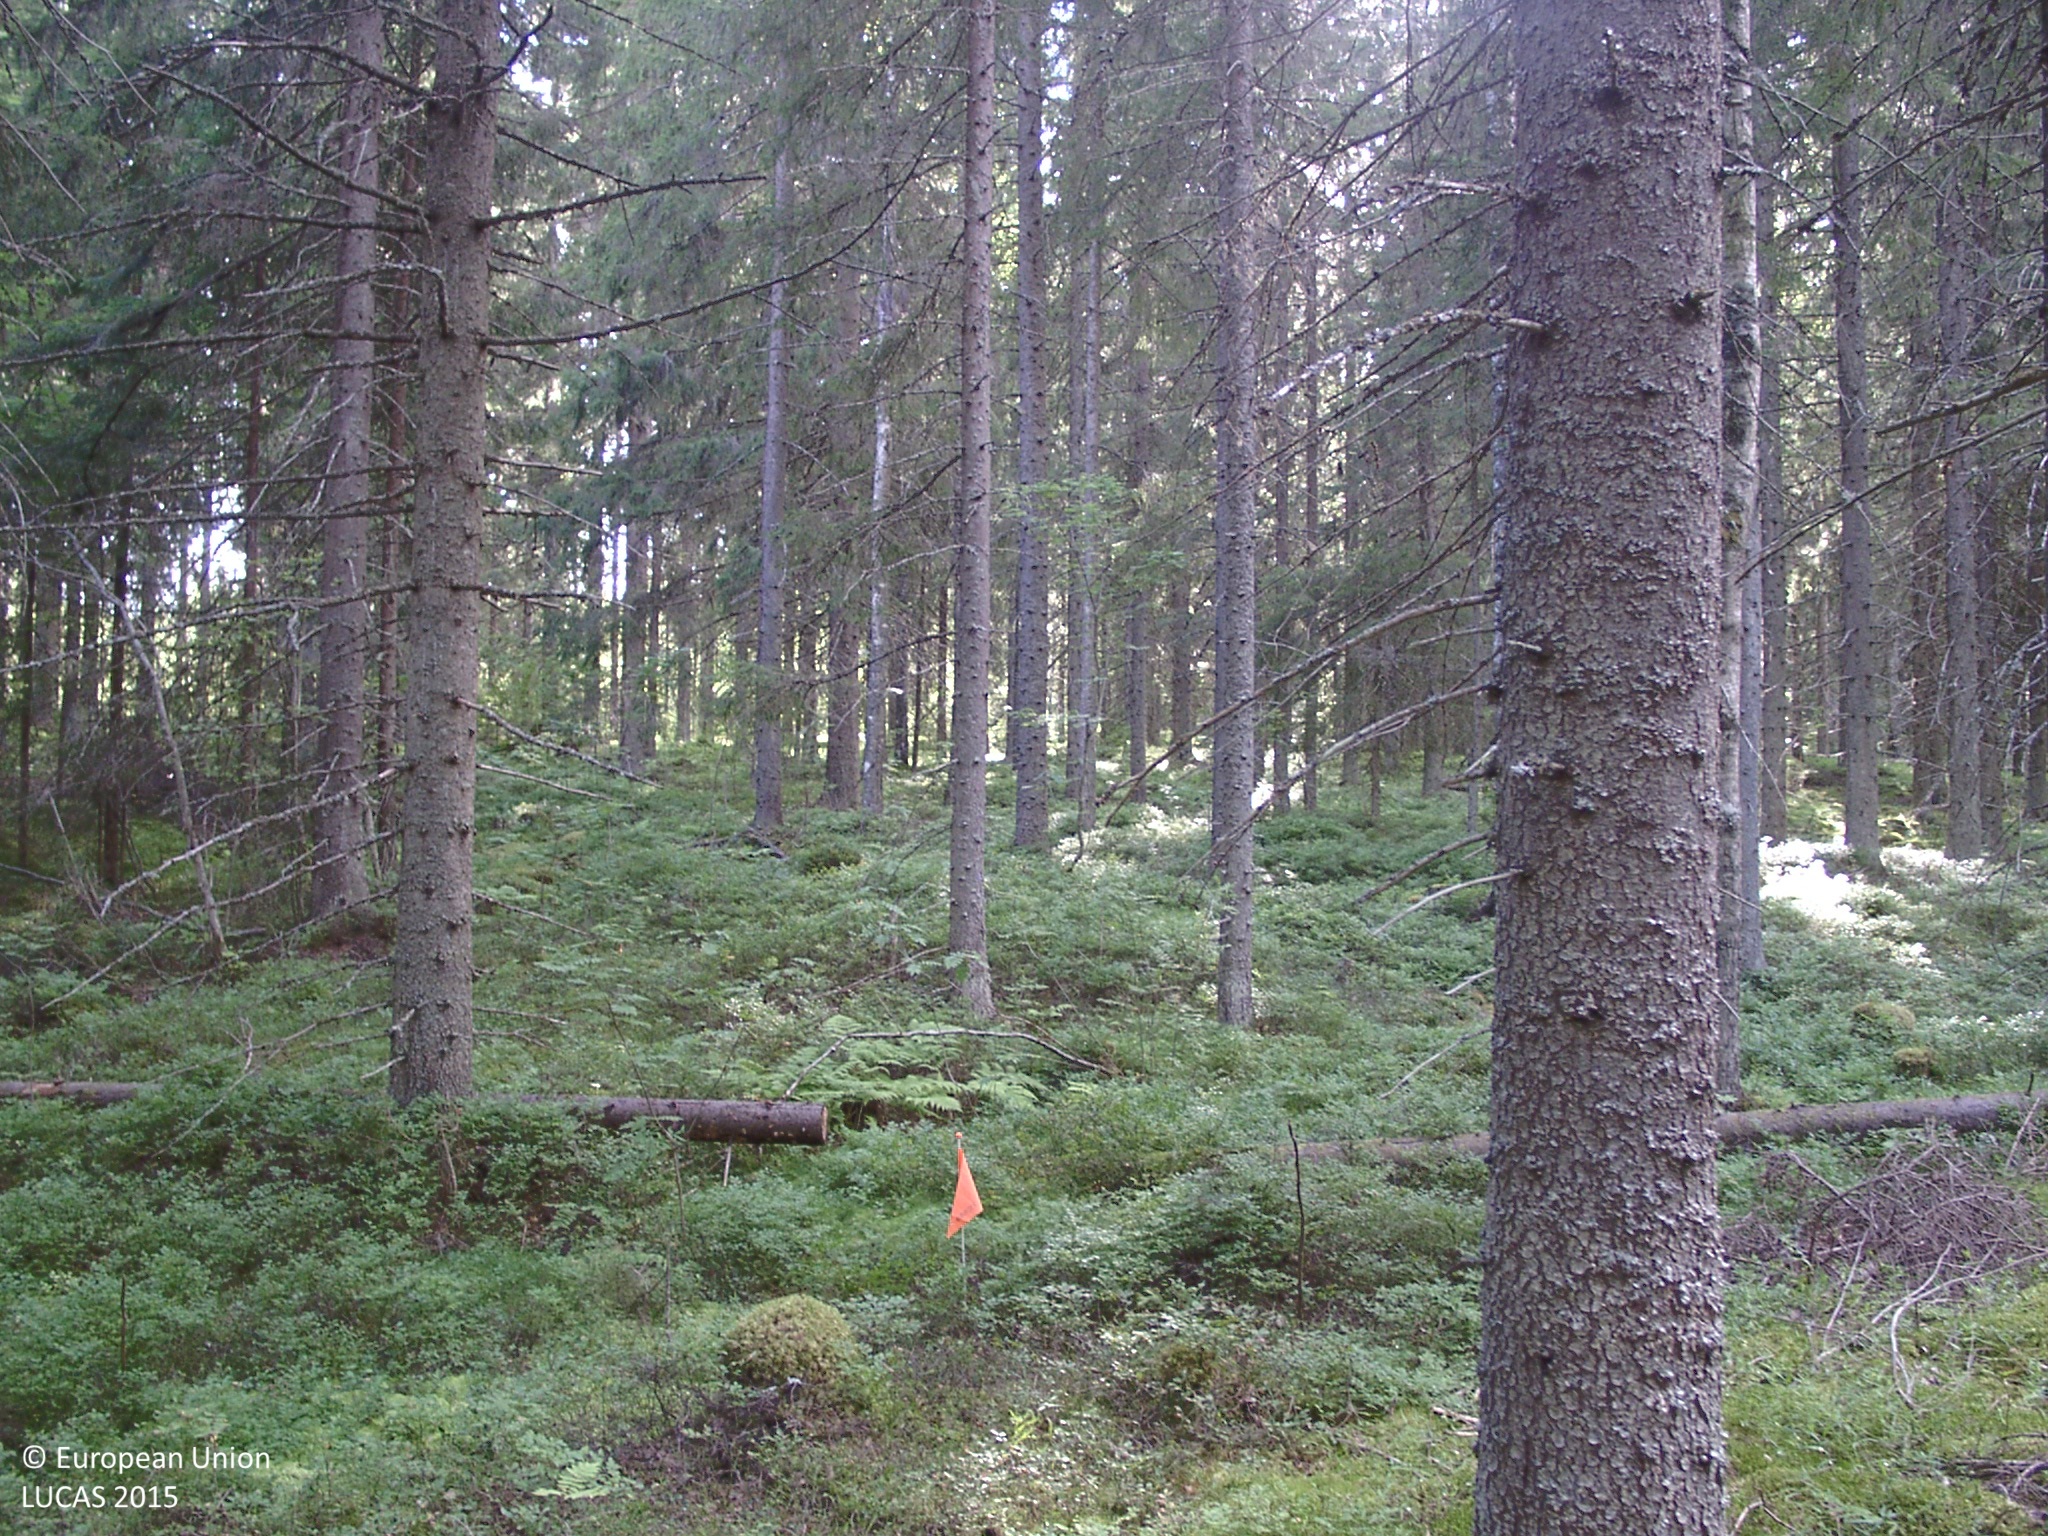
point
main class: Woodland
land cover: Spruce dominated coniferous woodland
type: boreal forest
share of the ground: > 75 %
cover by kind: coniferous forest trees 75 %, shrubs 10 %, broadleaved forest trees 5 %, herbaceous plants 5 %, lichens and mosses 5 %
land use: Forestry
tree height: > 5 m
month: August
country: FI
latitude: 62.4071
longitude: 25.5374
